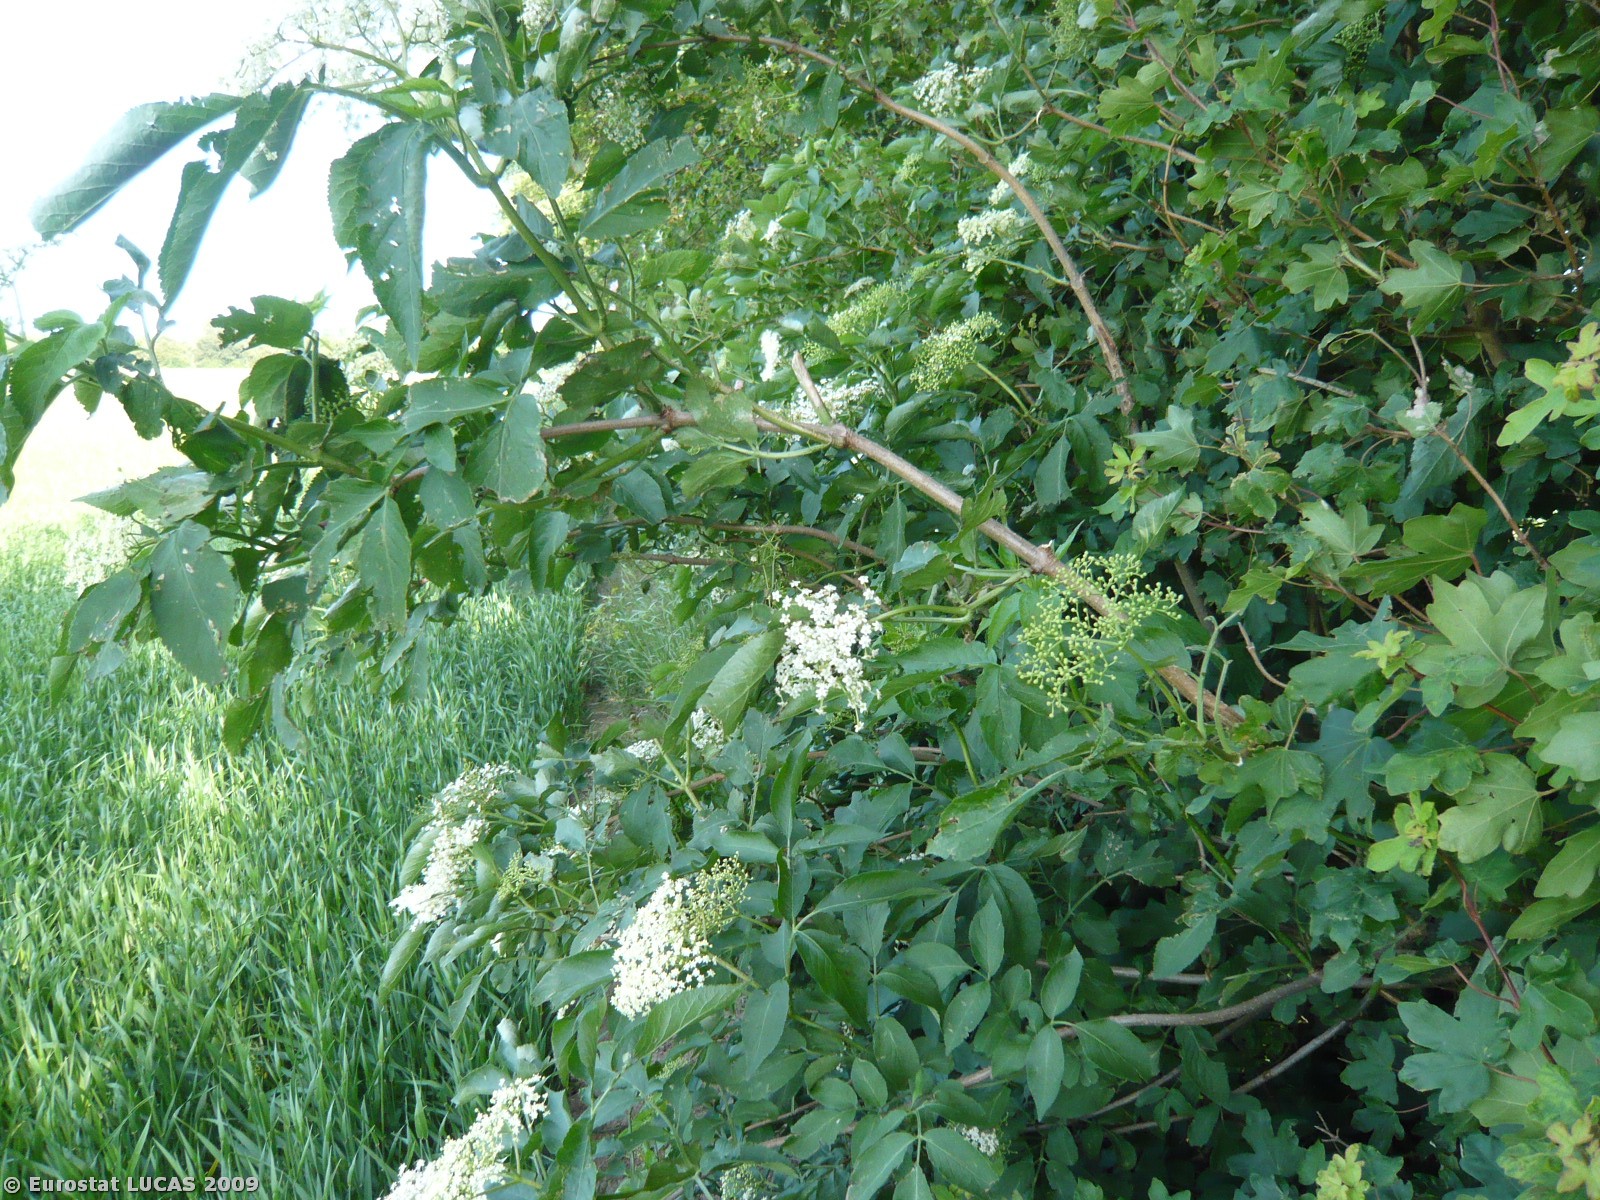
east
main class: Cropland
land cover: Barley
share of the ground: > 75 %
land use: Agriculture (excluding fallow land and kitchen gardens)
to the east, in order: Barley; Broadleaved woodland; Sugar beet; Broadleaved woodland
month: June
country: DK
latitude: 54.7791
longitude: 11.2896
